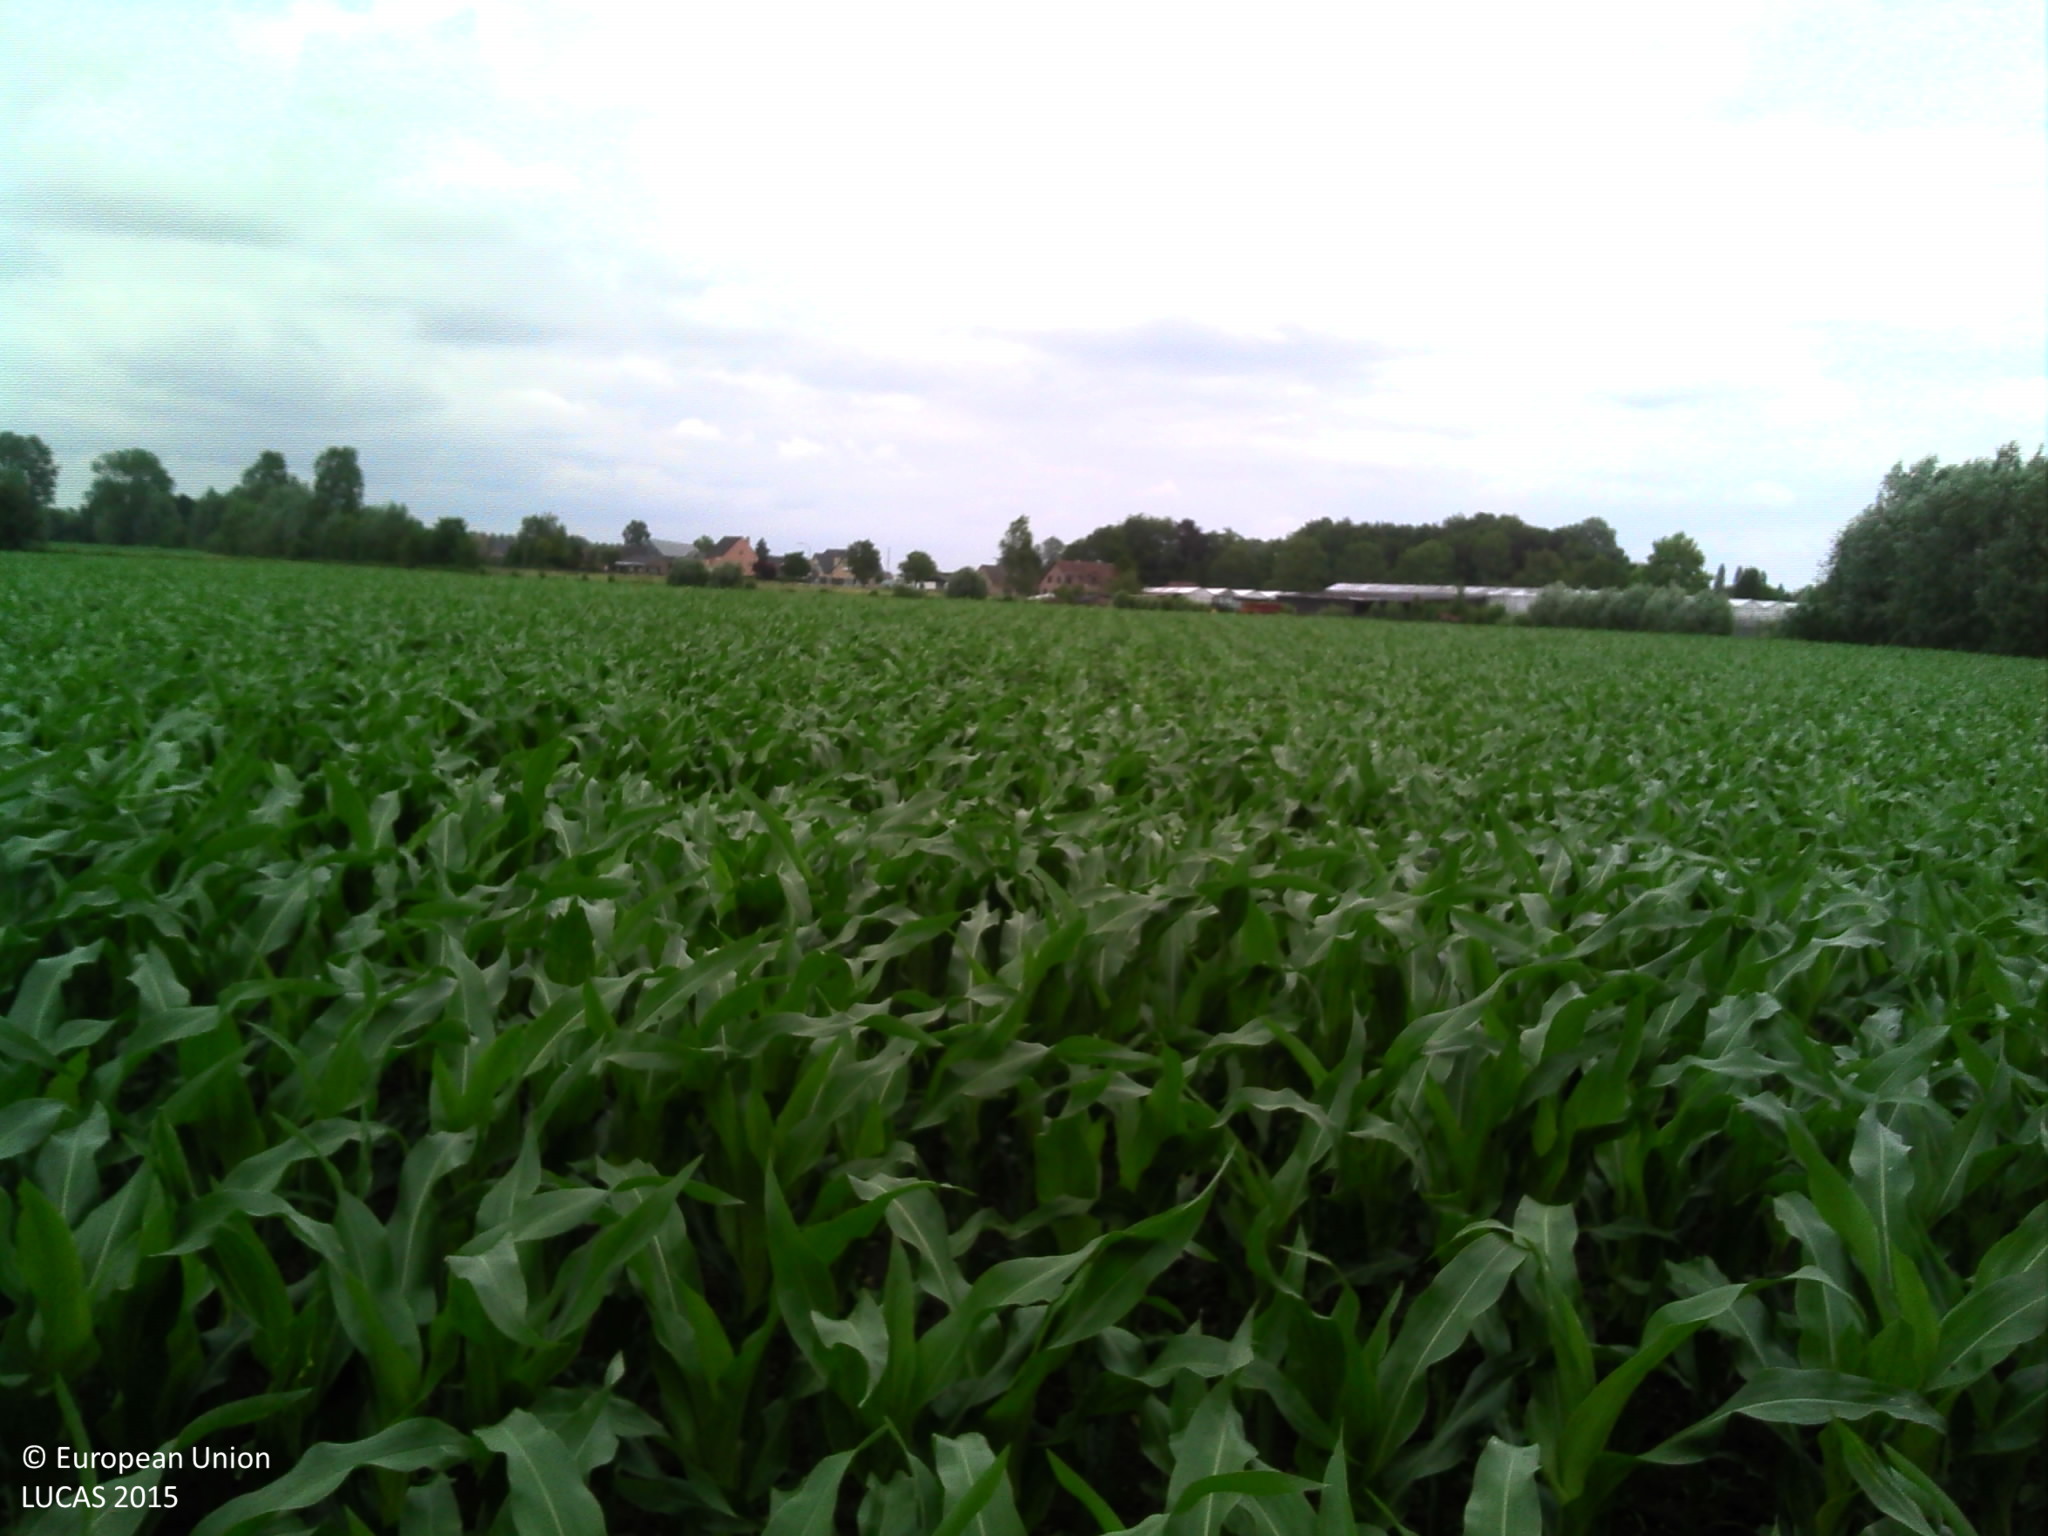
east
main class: Cropland
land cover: Maize
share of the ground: > 75 %
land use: Agriculture (excluding fallow land and kitchen gardens)
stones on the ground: < 10 %
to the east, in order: Maize; Tracks; Other fresh vegetables; Tracks; Grass margins; Ditches and canals; Artificial constructions in urban areas; Ditches and canals; Tracks
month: June
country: BE
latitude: 51.1205
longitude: 3.8932
